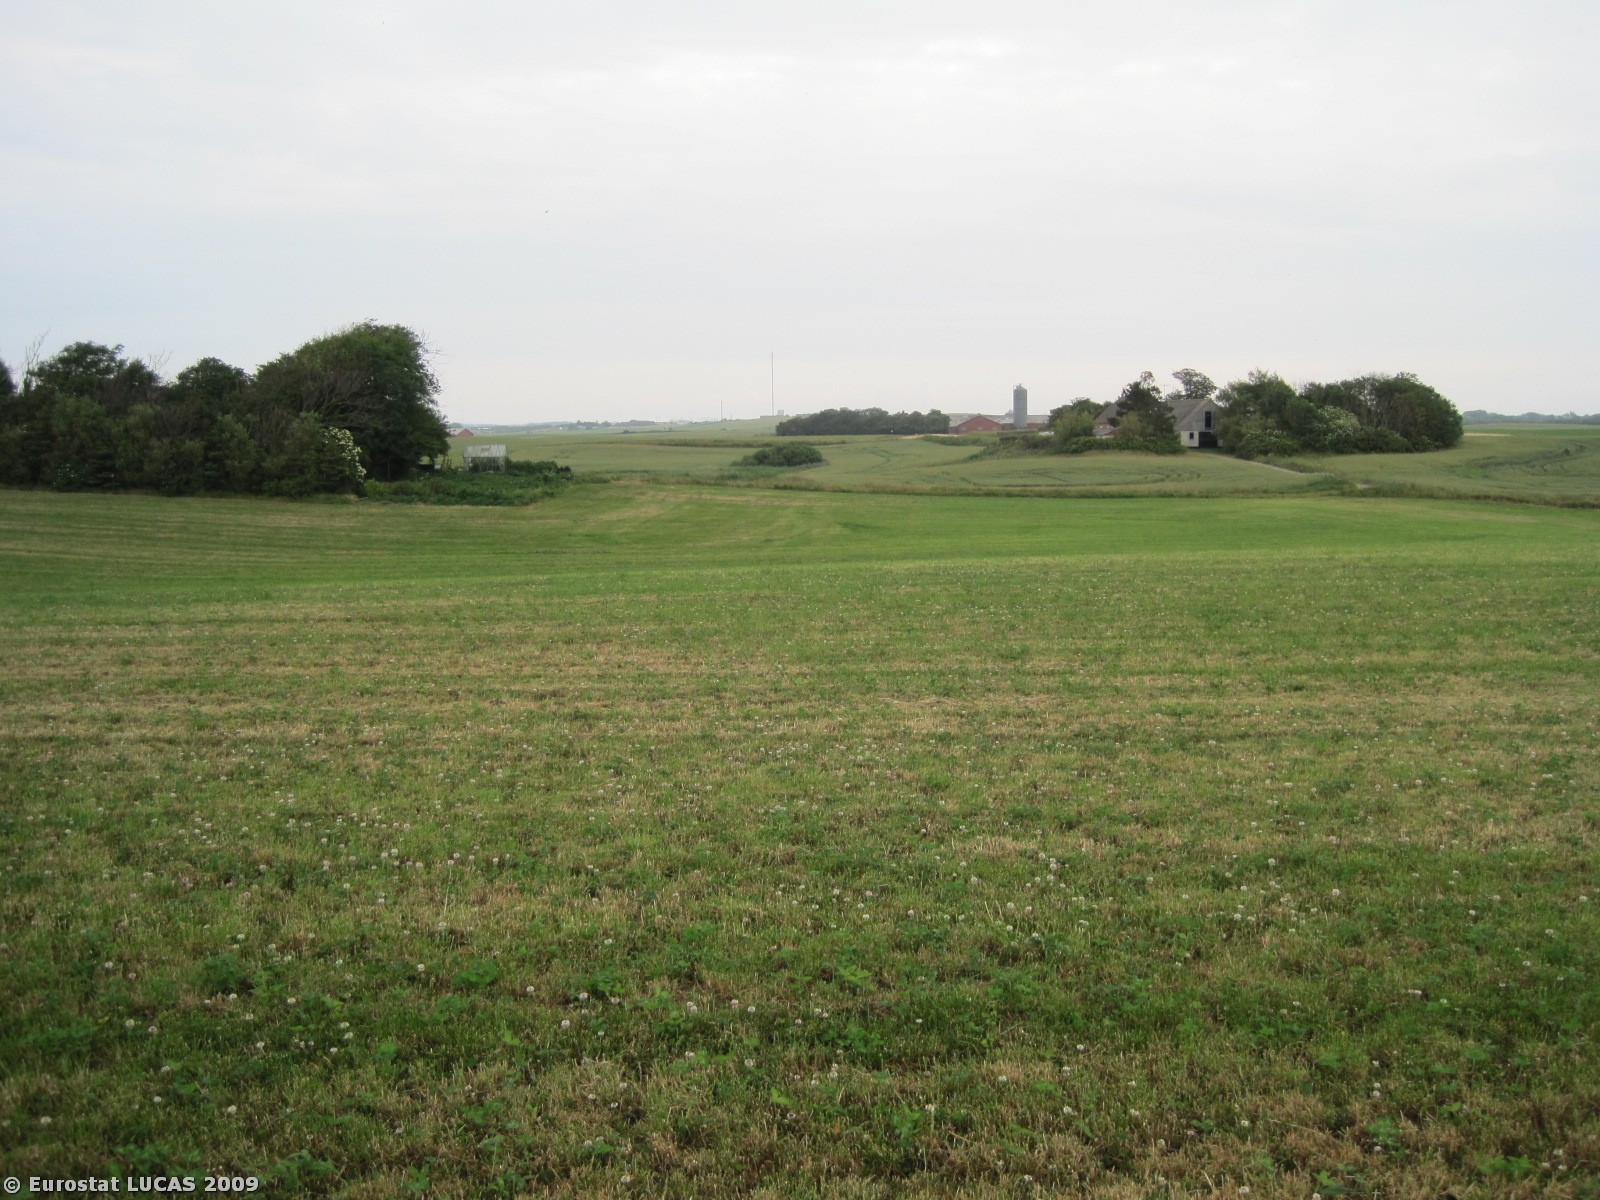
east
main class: Grassland
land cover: Grassland without tree/shrub cover
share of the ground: > 75 %
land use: Agriculture (excluding fallow land and kitchen gardens)
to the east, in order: Grassland without tree/shrub cover; Tracks; Grass margins; Common wheat
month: June
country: DK
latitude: 56.5356
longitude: 8.2622
